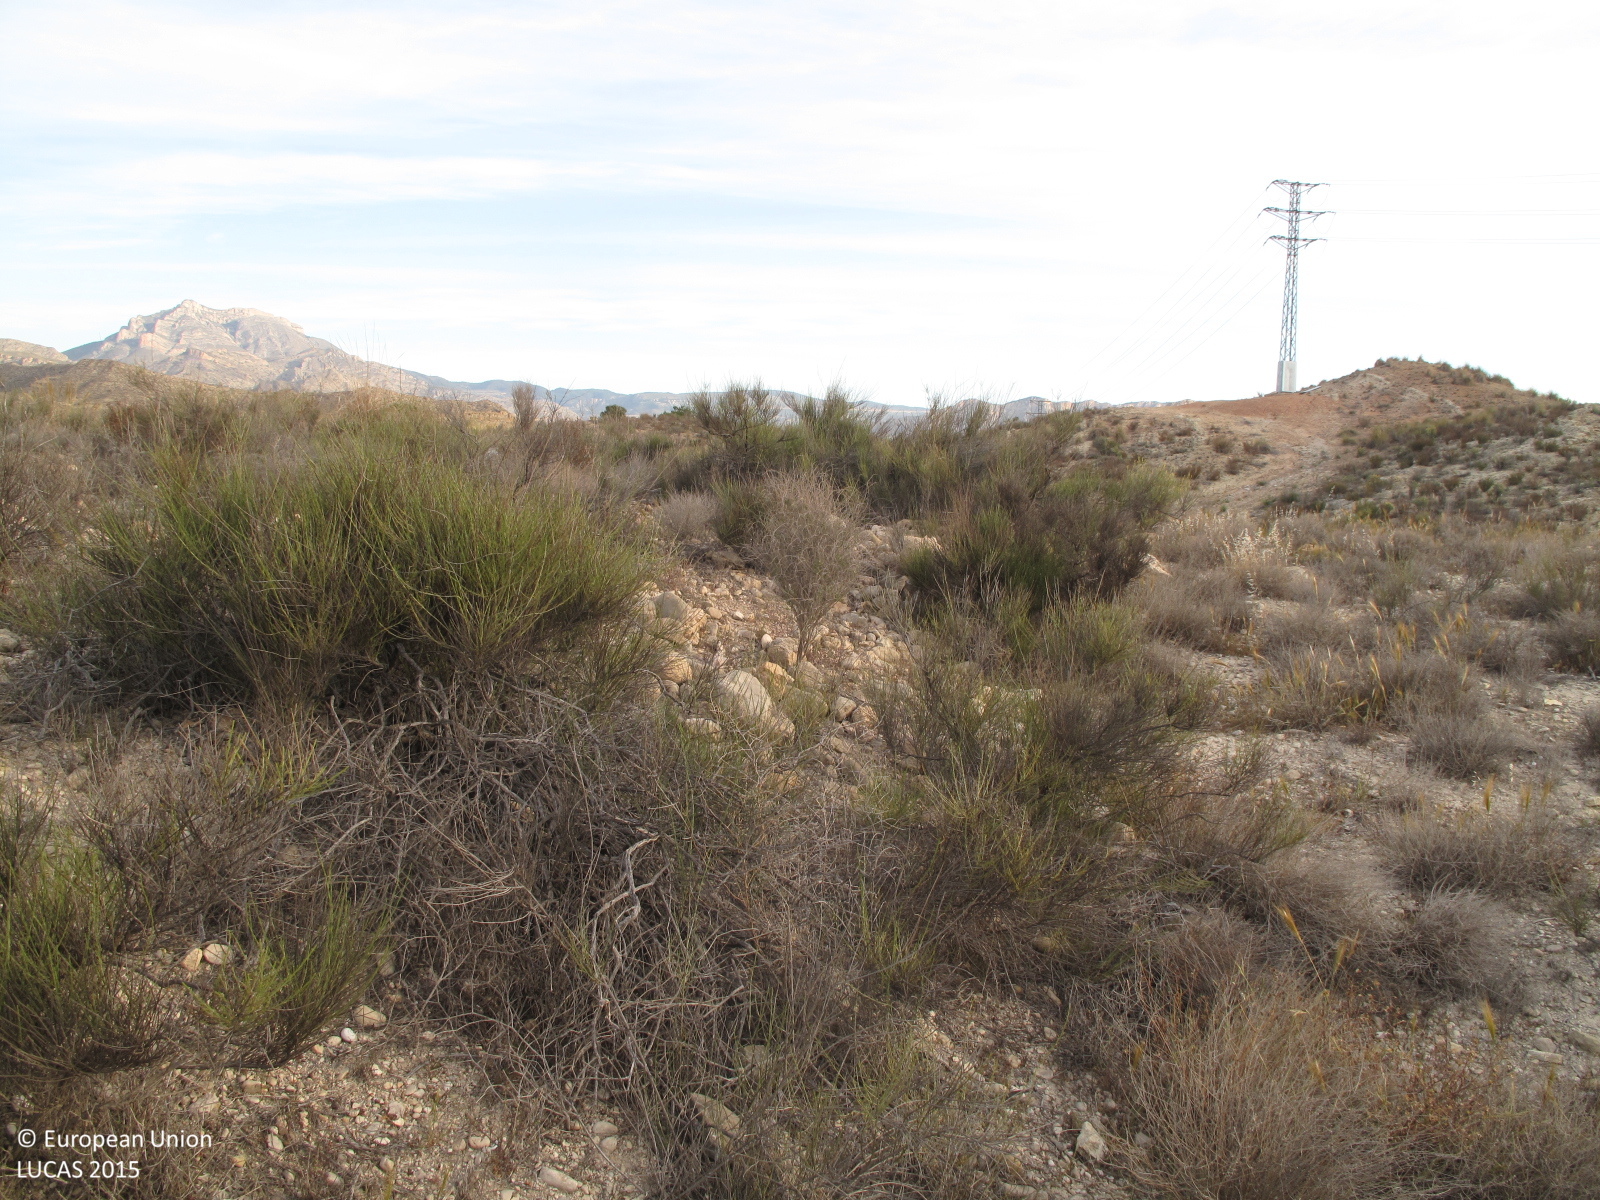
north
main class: Shrubland
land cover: Shrubland without tree cover
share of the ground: 25 - 50 %
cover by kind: consolidated bare surface 50 %, shrubs 30 %, herbaceous plants 20 %
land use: Semi-natural and natural areas not in use
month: April
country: ES
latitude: 38.4646
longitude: -0.4733
